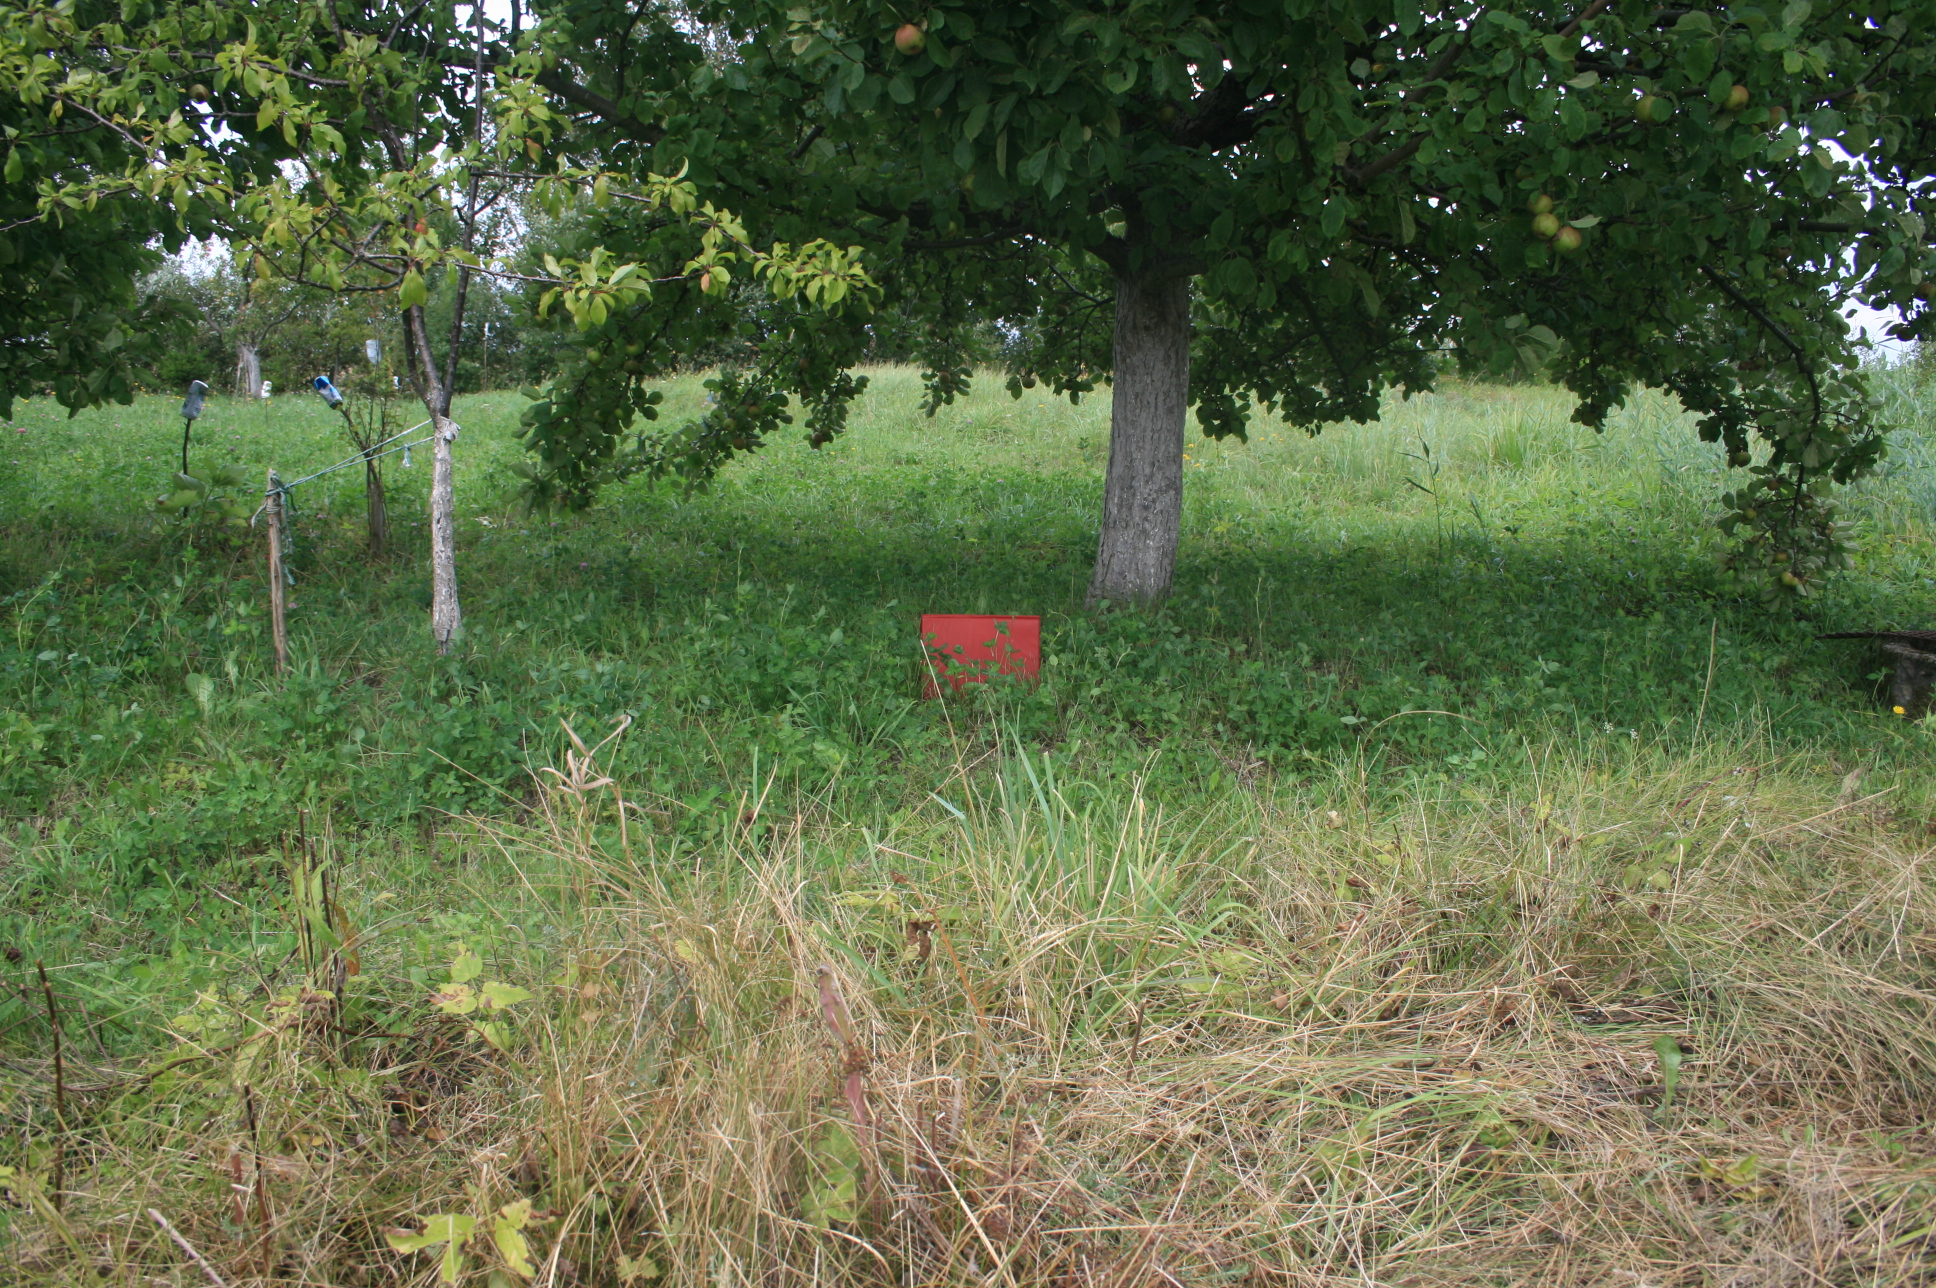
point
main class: Cropland
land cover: Apple fruit
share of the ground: 50 - 75 %
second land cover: Grassland without tree/shrub cover
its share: > 75 %
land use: Kitchen garden
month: September
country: LT
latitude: 55.7028
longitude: 21.3249
